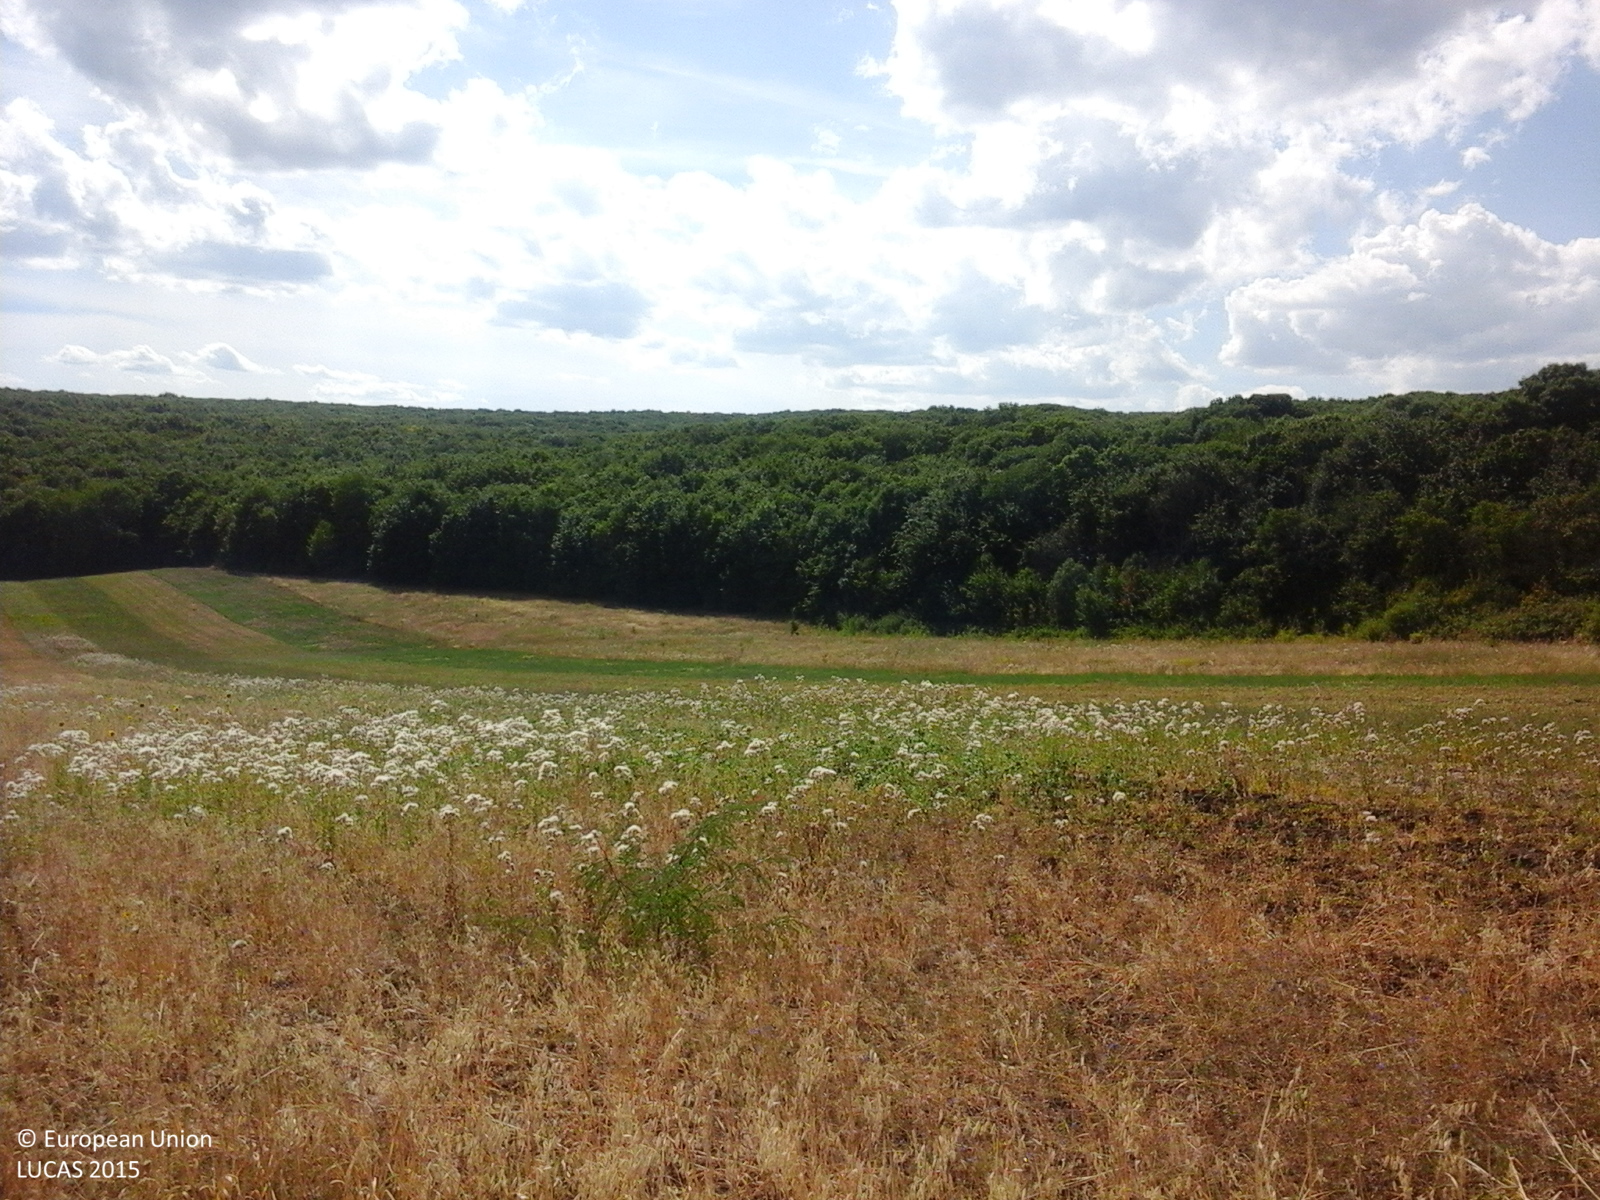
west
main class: Woodland
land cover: Broadleaved woodland
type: acidophilous oak and oak-birch forest
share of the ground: > 75 %
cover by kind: broadleaved forest trees 100 %
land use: Forestry
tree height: > 5 m
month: July
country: RO
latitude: 46.2093
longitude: 27.8905
